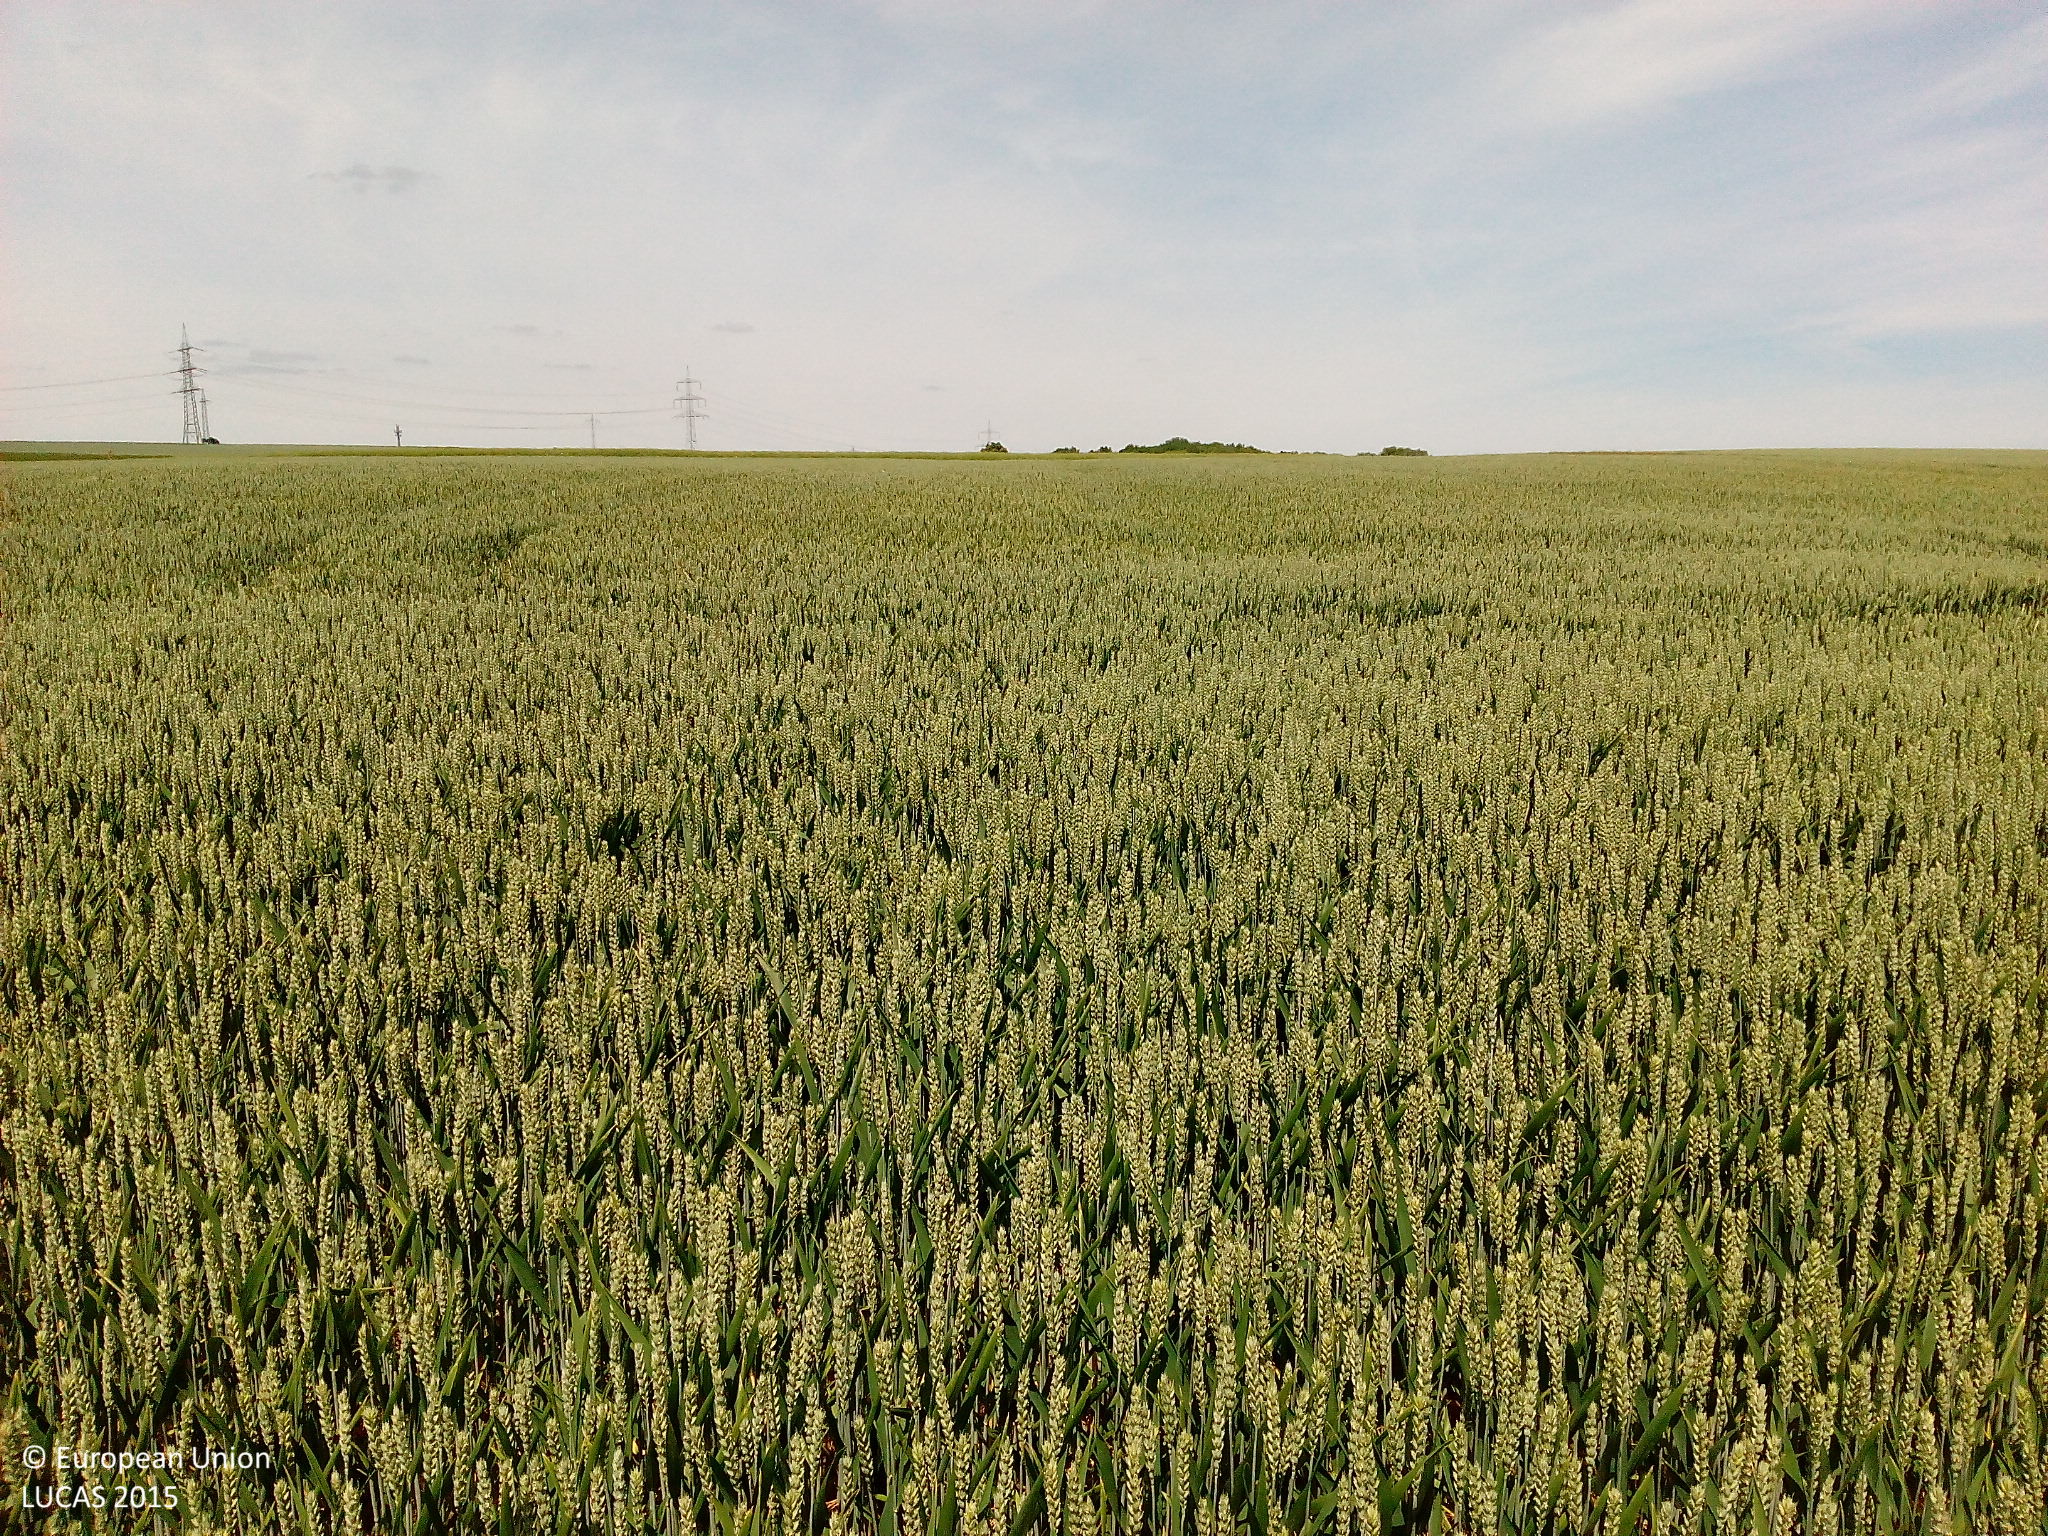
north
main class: Cropland
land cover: Common wheat
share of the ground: > 75 %
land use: Agriculture (excluding fallow land and kitchen gardens)
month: June
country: DE
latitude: 50.8826
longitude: 9.1901
